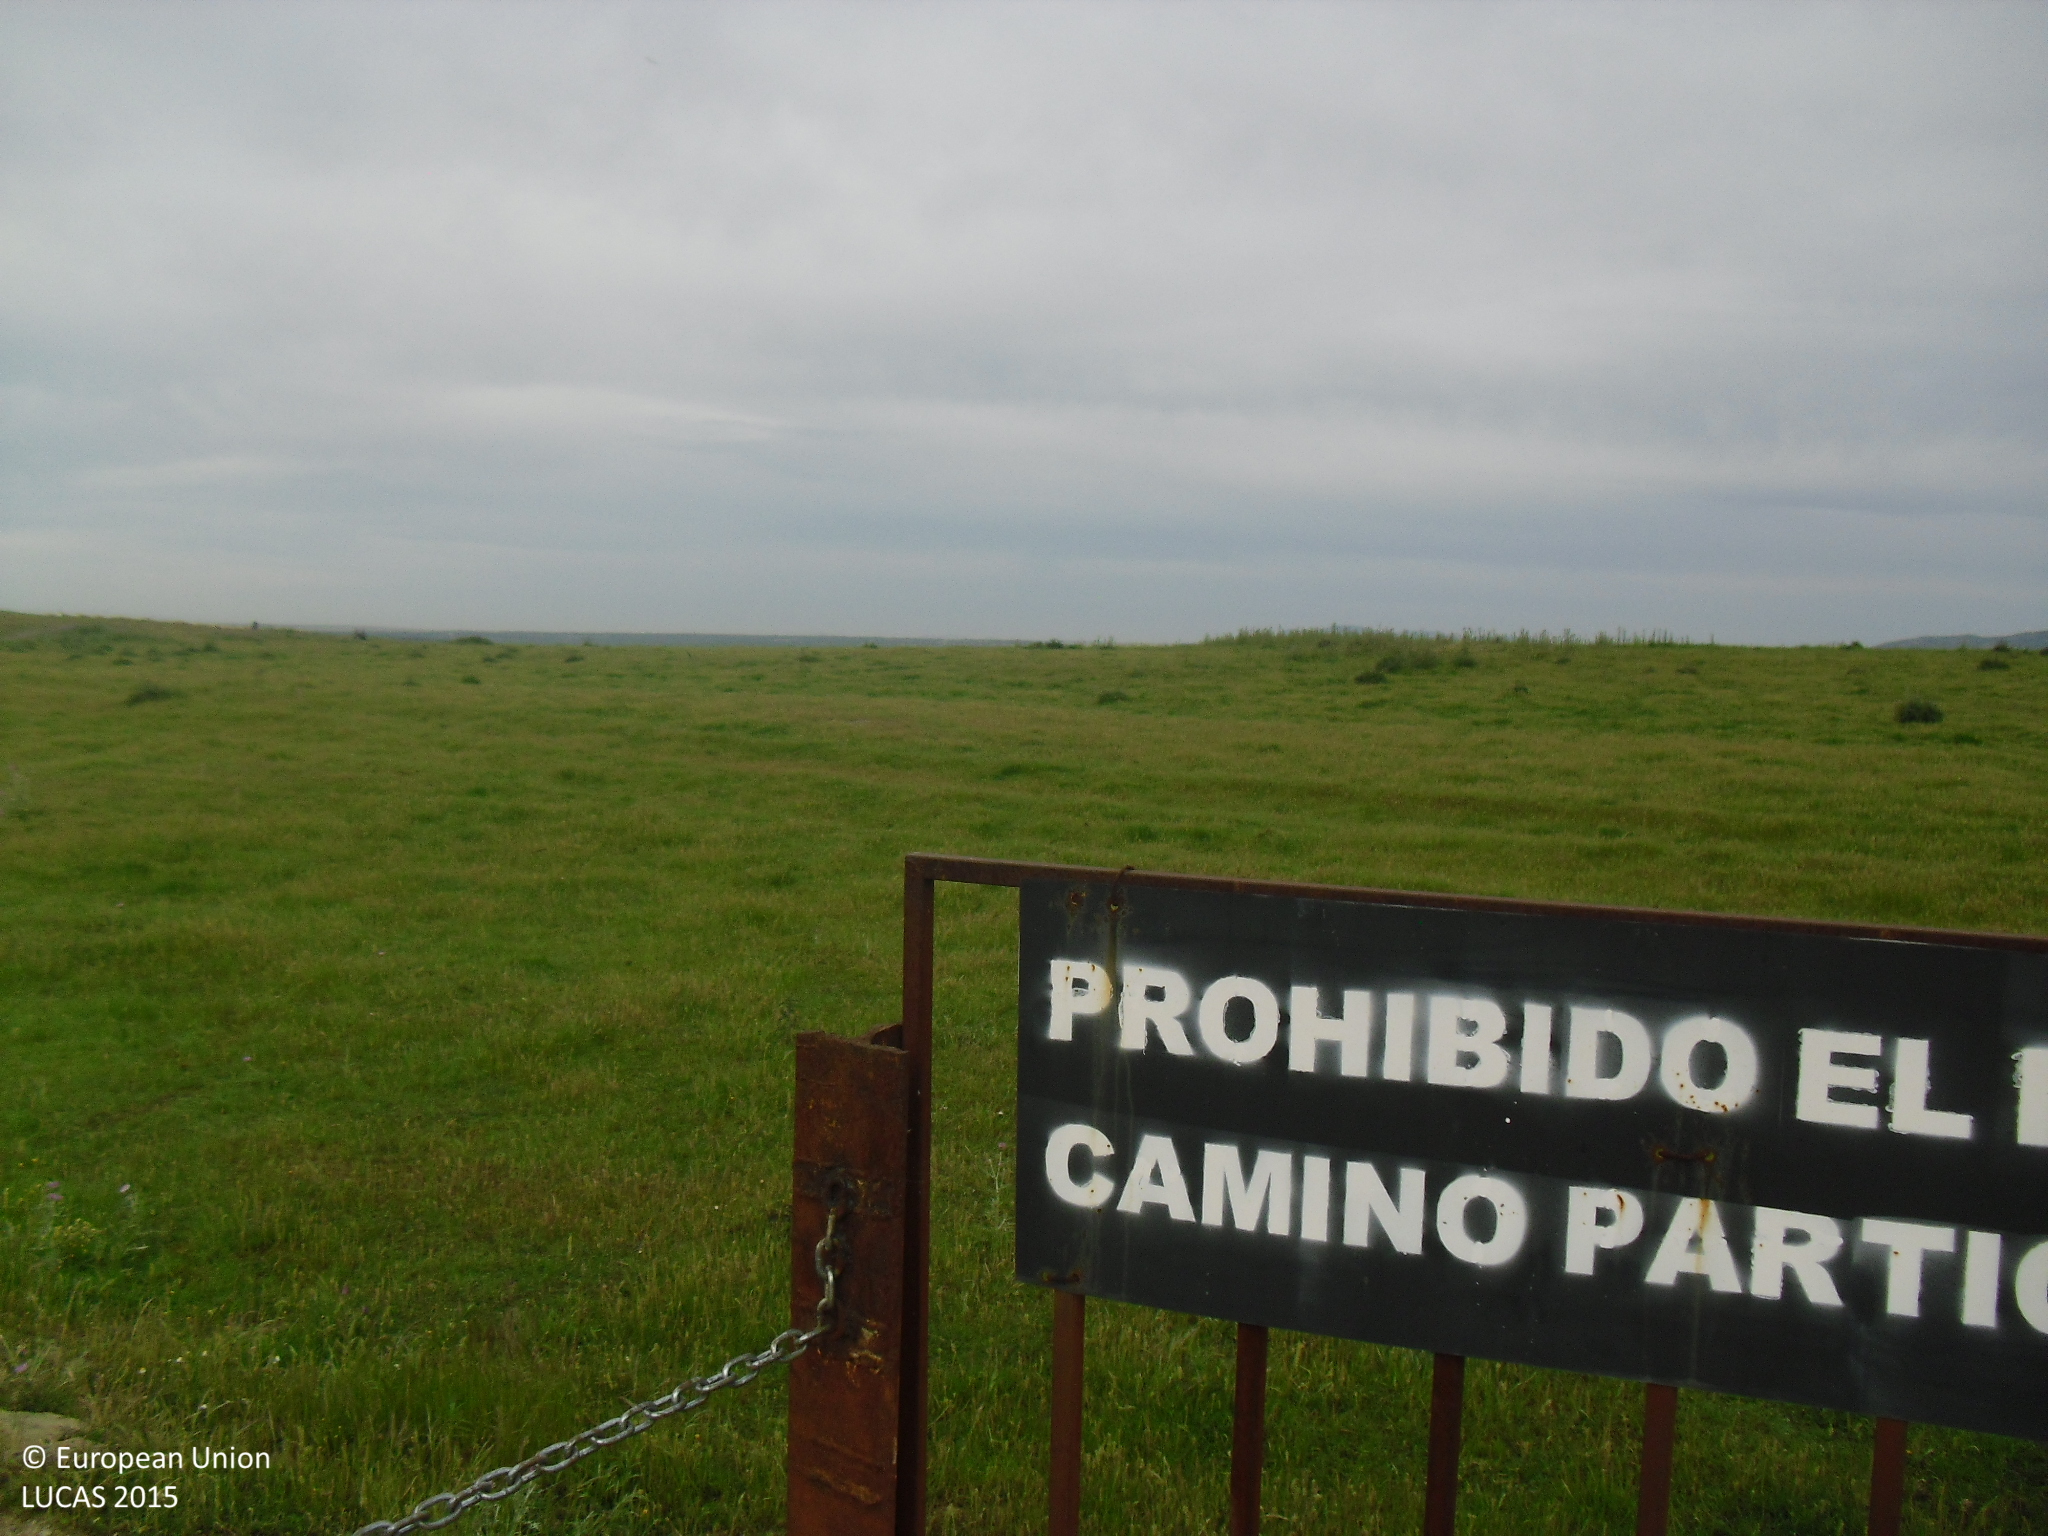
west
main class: Woodland
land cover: Broadleaved woodland
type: broadleaved evergreen forest
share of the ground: 10 - 25 %
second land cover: Grassland without tree/shrub cover
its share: > 75 %
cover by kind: herbaceous plants 70 %, broadleaved forest trees 20 %, shrubs 10 %
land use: Forestry
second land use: Agriculture (excluding fallow land and kitchen gardens)
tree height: > 5 m
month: May
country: ES
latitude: 39.3085
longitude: -5.5789
